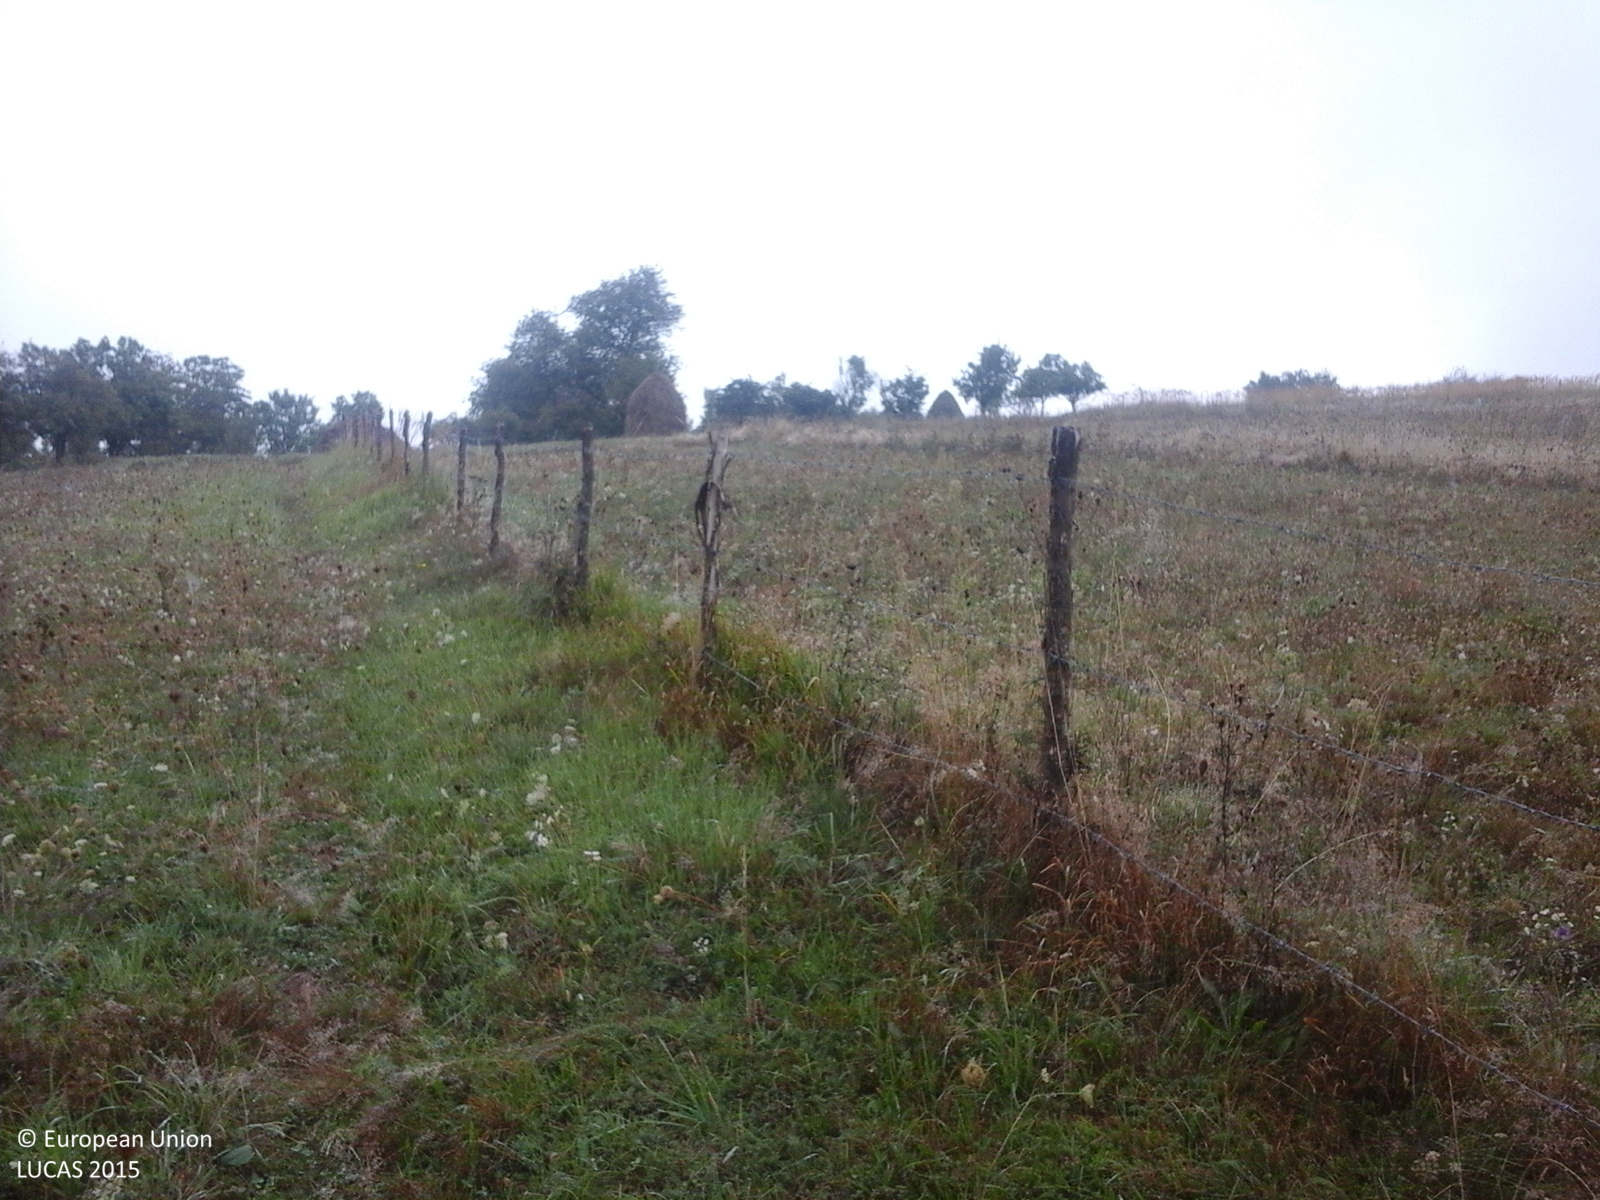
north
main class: Grassland
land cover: Grassland without tree/shrub cover
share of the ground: > 75 %
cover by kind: herbaceous plants 100 %
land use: Agriculture (excluding fallow land and kitchen gardens)
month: September
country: RO
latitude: 46.9124
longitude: 22.4608
